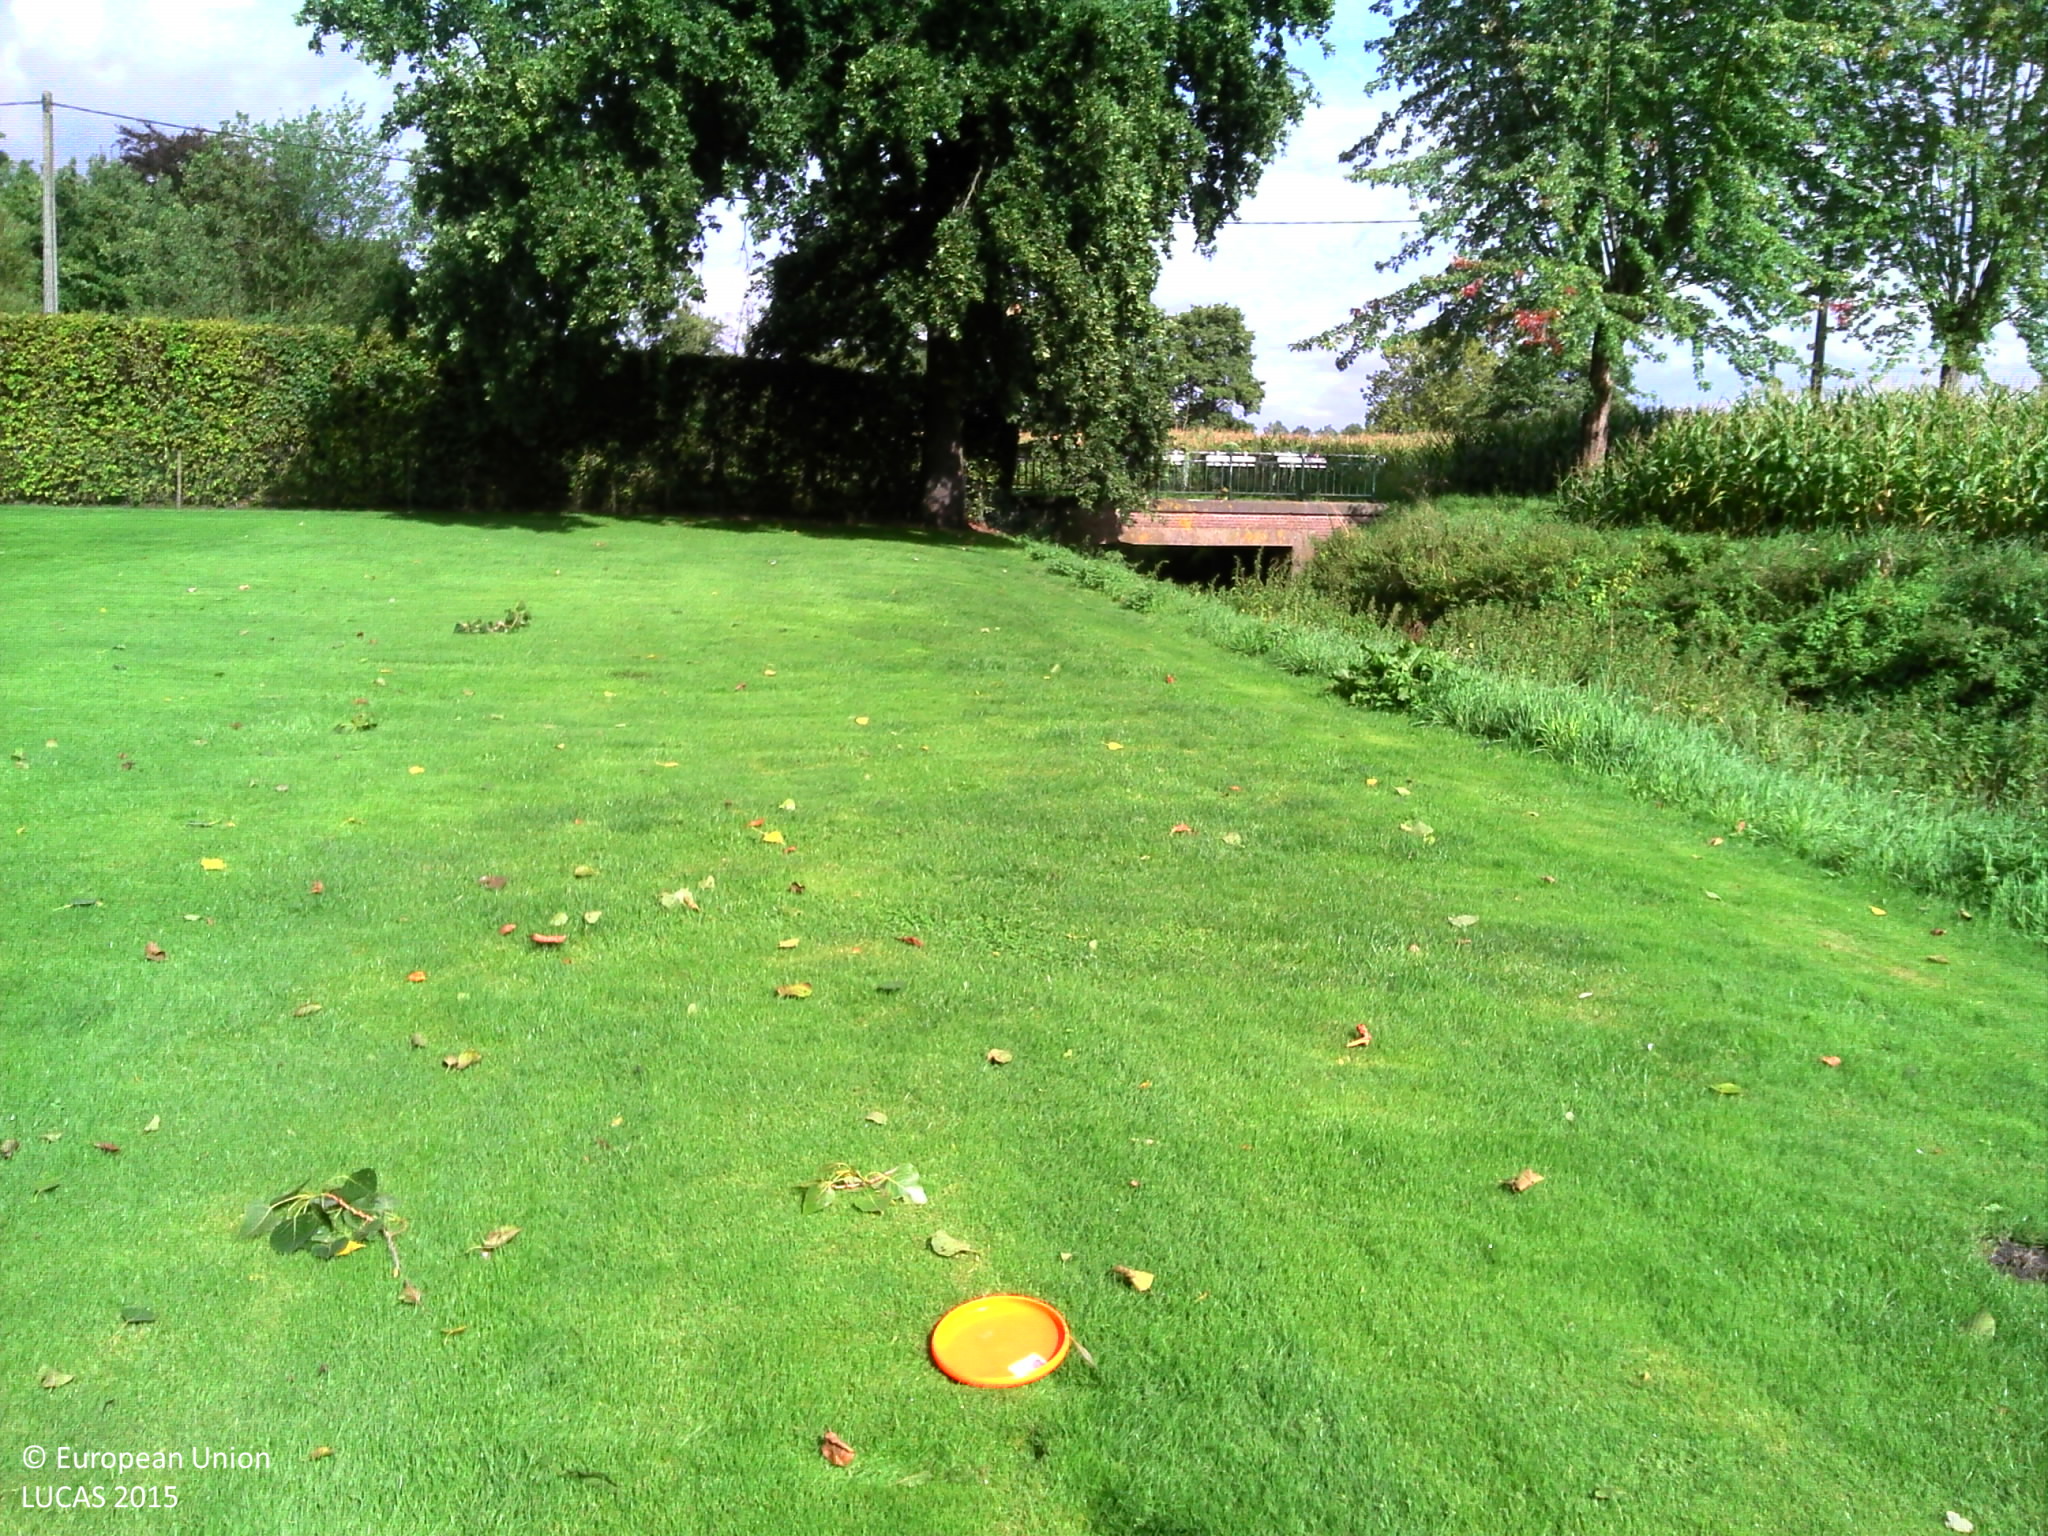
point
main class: Grassland
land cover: Grassland without tree/shrub cover
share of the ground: > 75 %
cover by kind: herbaceous plants 100 %
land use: Residential
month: September
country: BE
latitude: 51.4744
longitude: 4.4815
